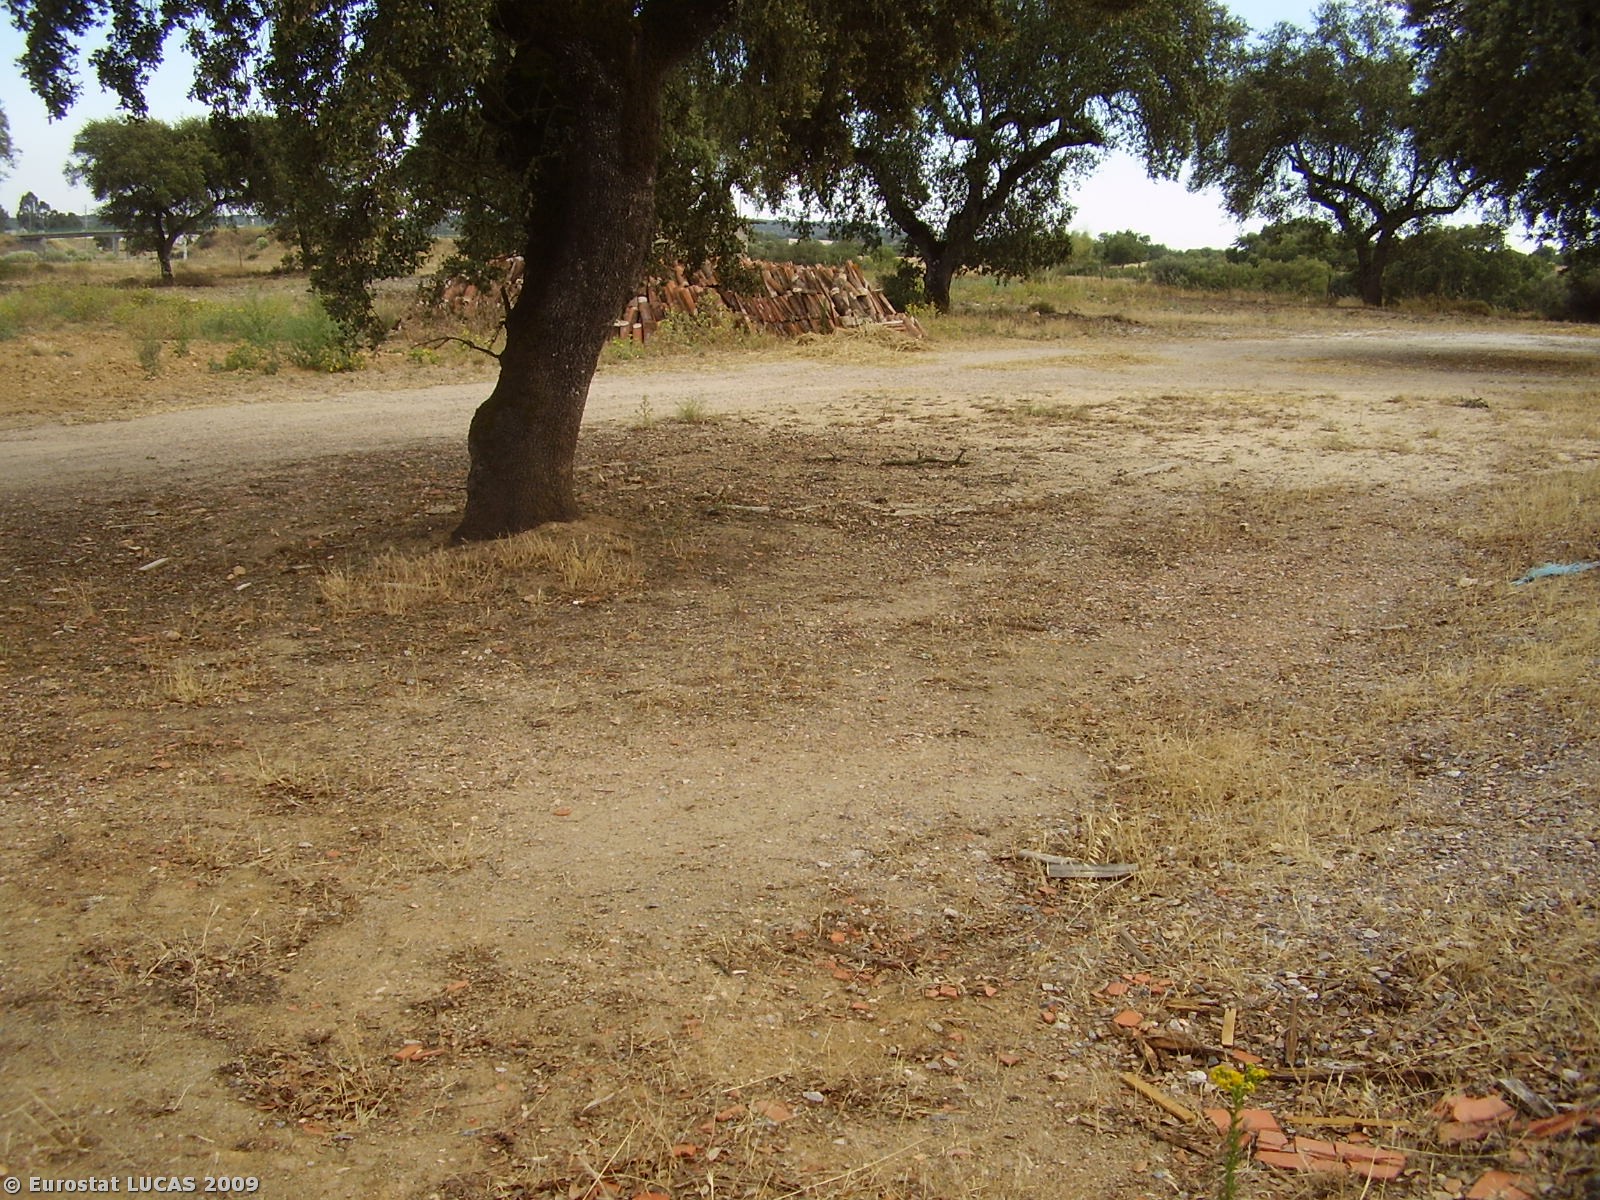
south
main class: Woodland
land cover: Broadleaved woodland
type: broadleaved evergreen forest
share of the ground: 10 - 25 %
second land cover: Bare land
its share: 50 - 75 %
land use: Forestry
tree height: > 5 m
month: July
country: PT
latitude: 38.7197
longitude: -7.7861
